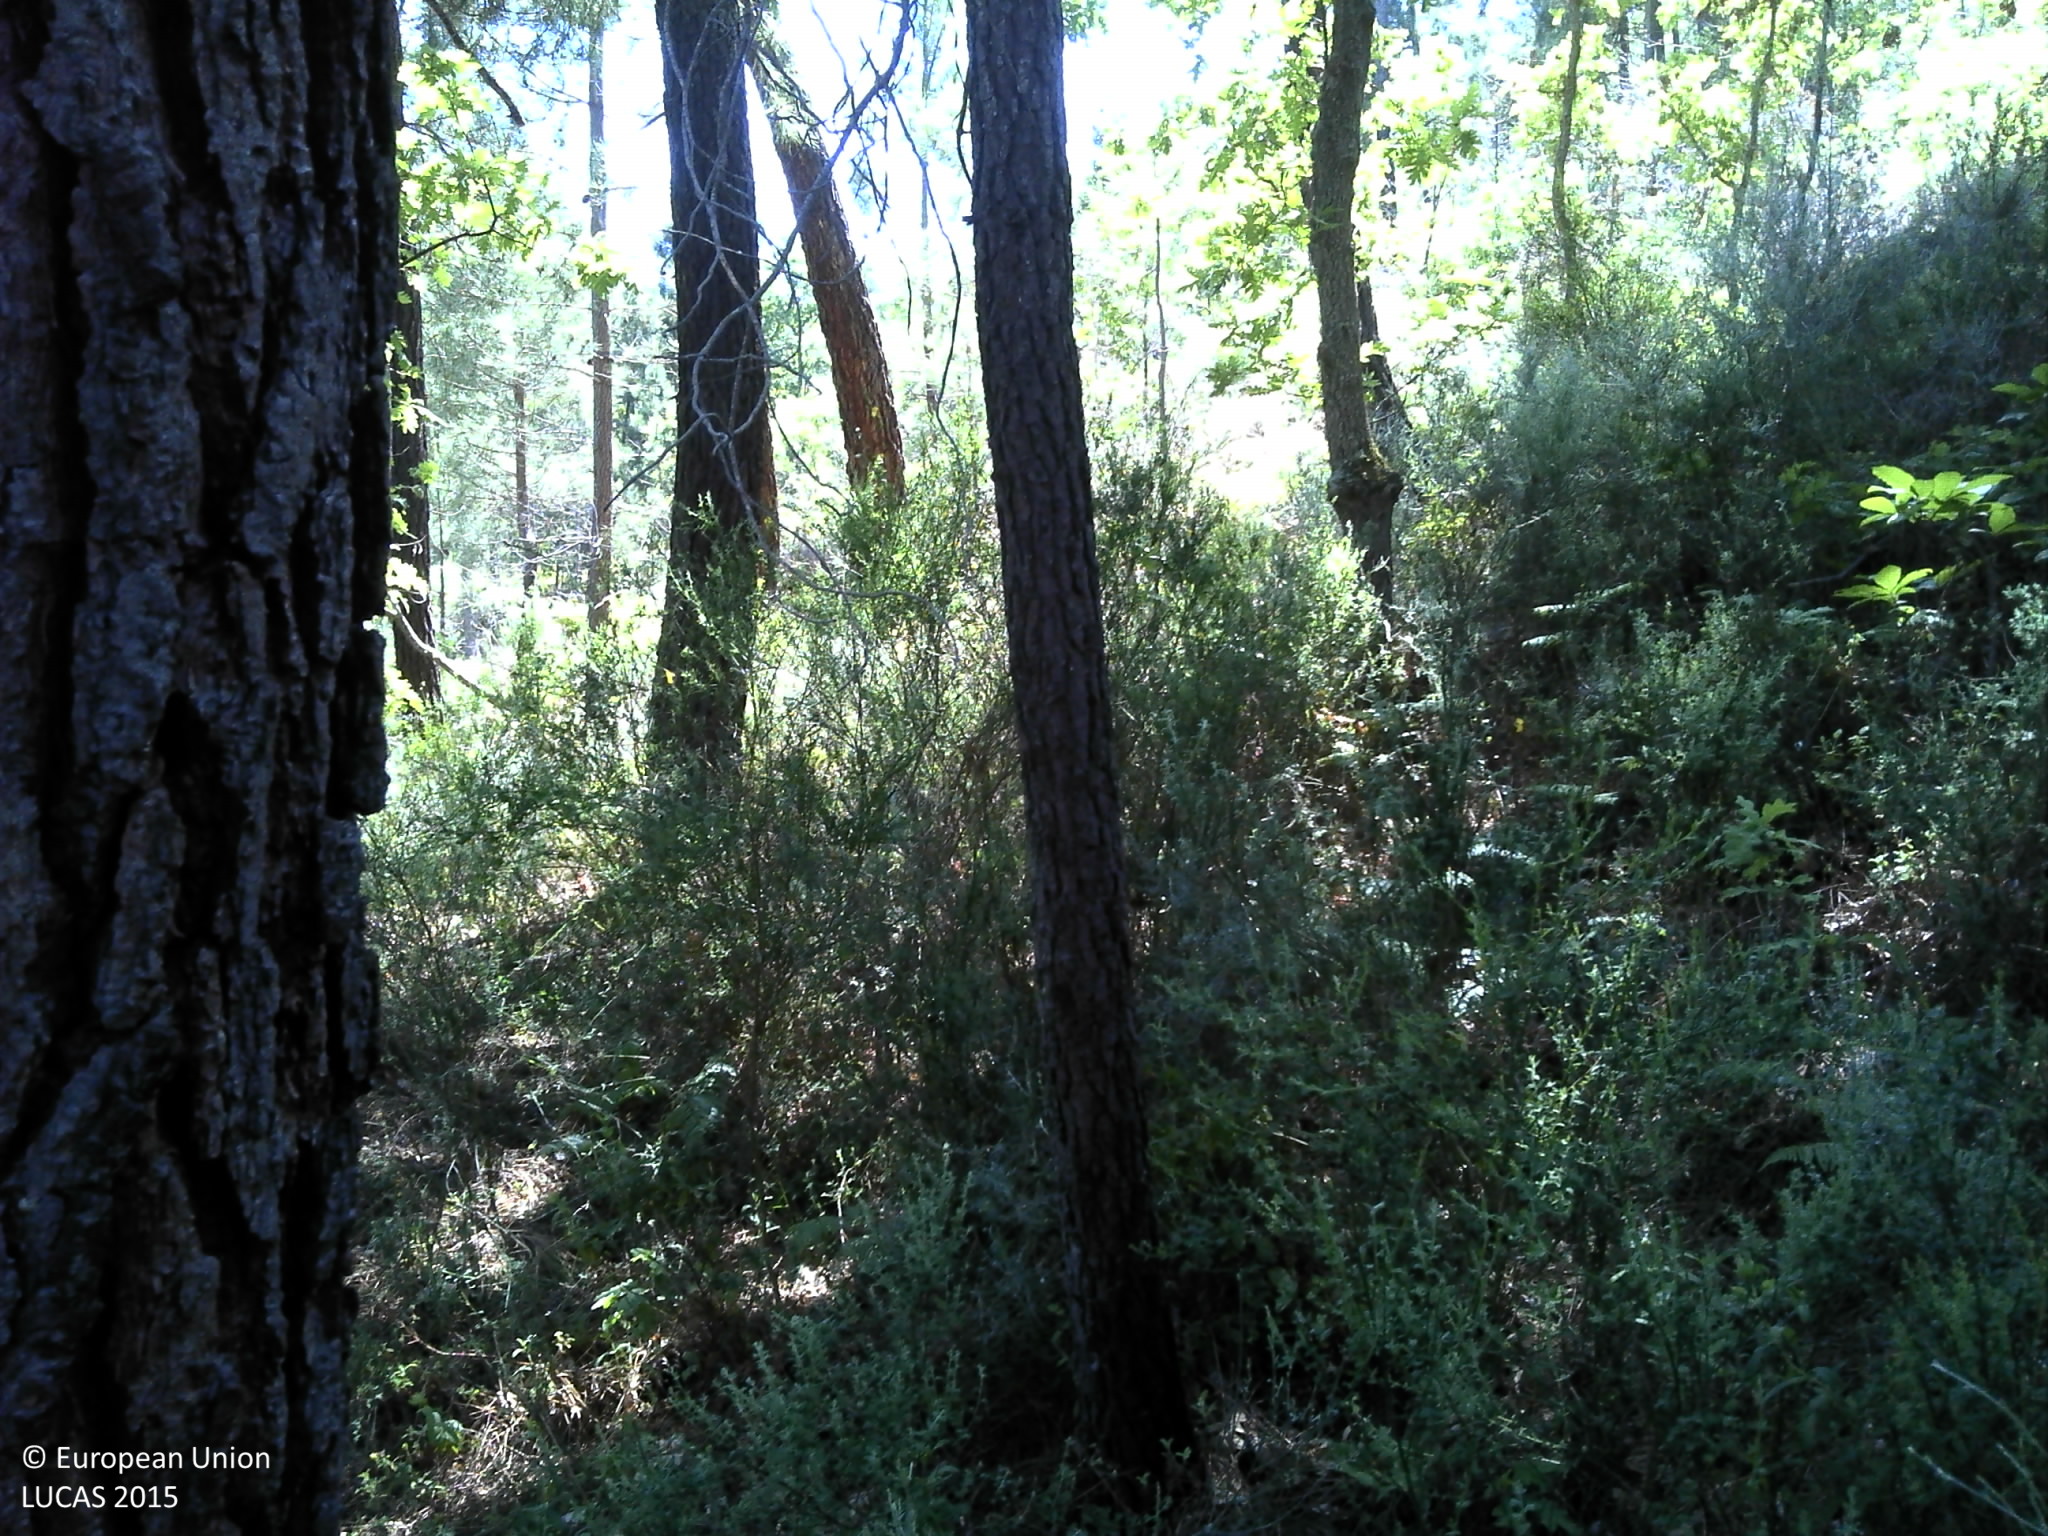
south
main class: Woodland
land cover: Pine dominated coniferous woodland
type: coniferous forest of the mediterranean region
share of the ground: 50 - 75 %
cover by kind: coniferous forest trees 60 %, shrubs 30 %, broadleaved forest trees 5 %, unconsolidated bare surface 5 %
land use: Forestry
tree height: > 5 m
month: May
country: PT
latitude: 41.5936
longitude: -7.5123
